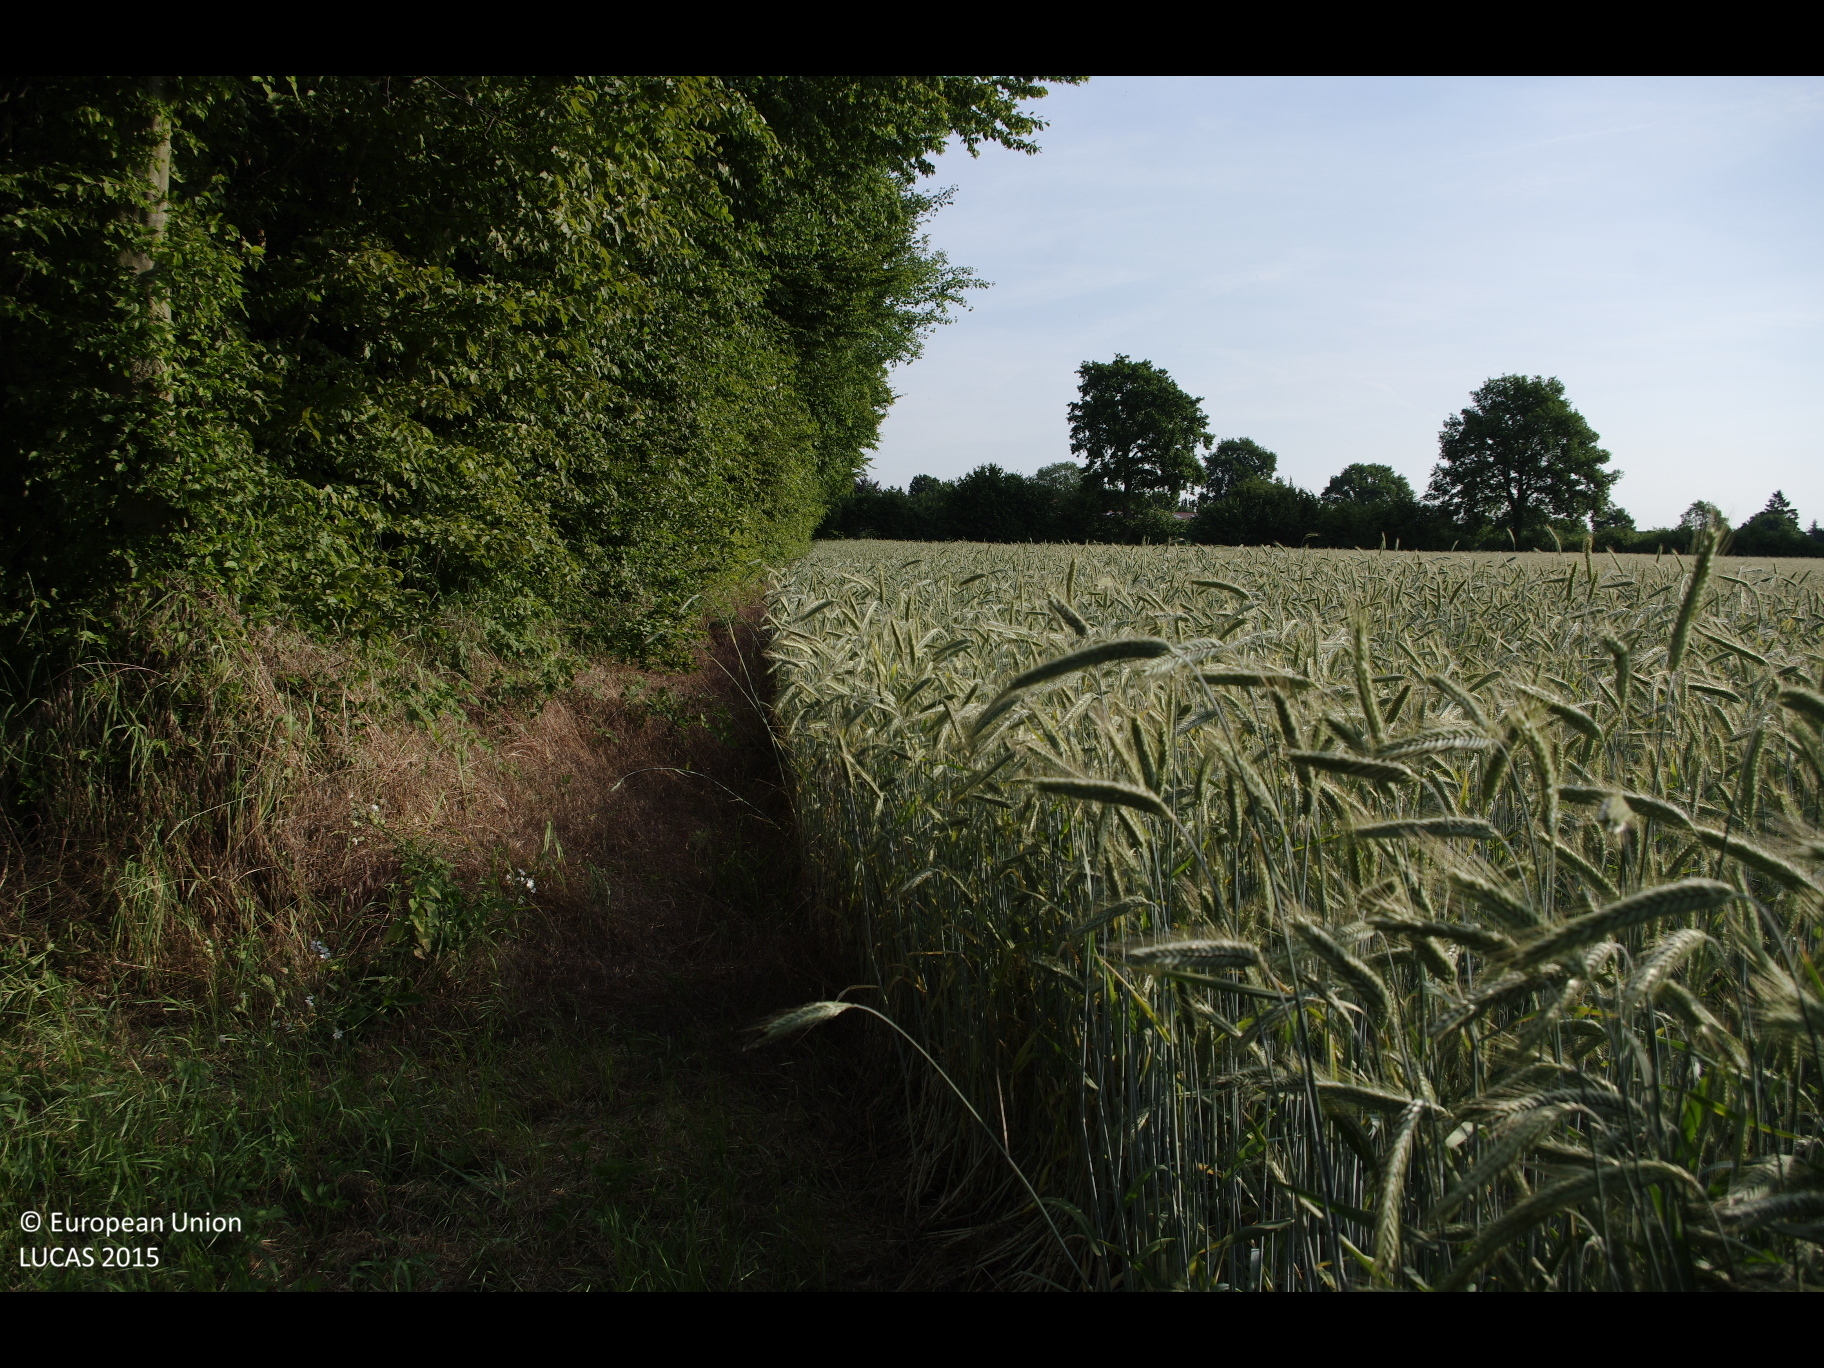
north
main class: Cropland
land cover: Rye
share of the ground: > 75 %
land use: Agriculture (excluding fallow land and kitchen gardens)
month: July
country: DE
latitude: 53.7957
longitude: 10.6221
